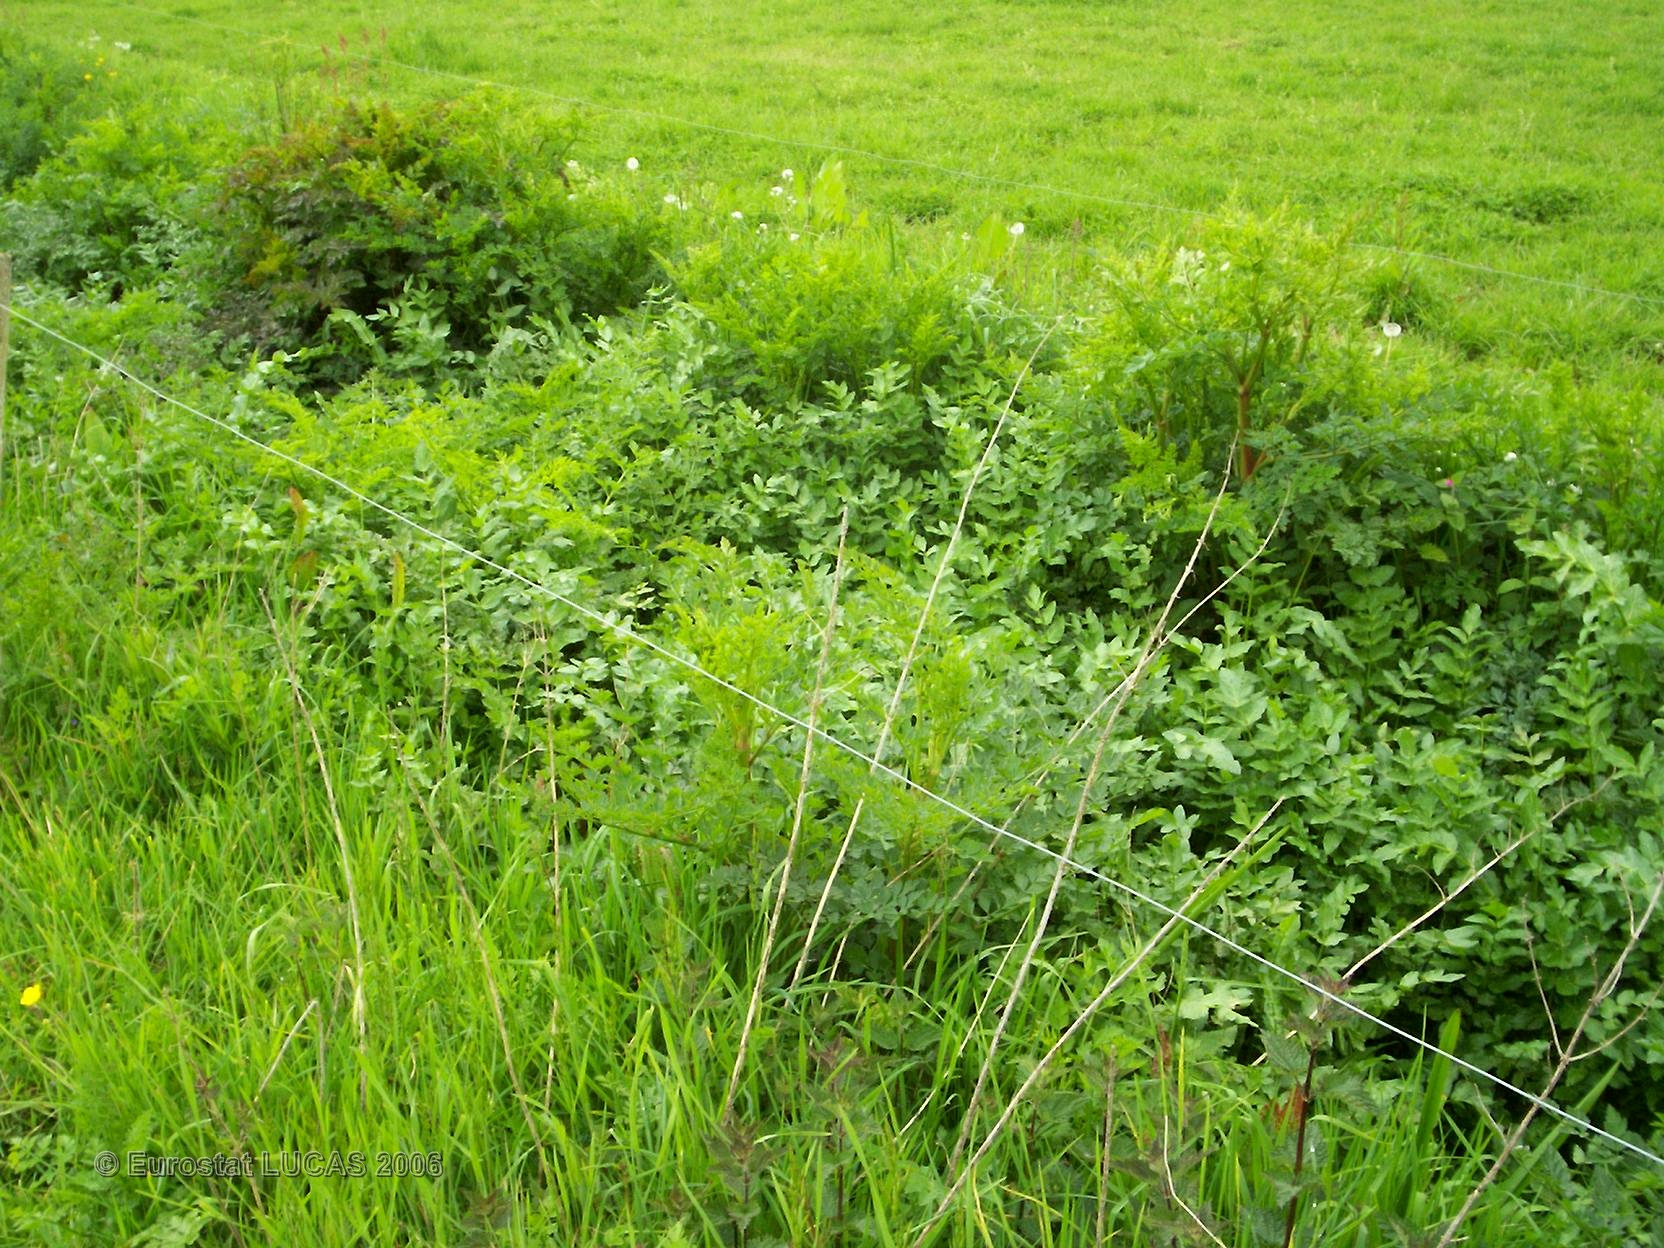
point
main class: Grassland
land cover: Grassland without tree/shrub cover
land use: Agriculture (excluding fallow land and kitchen gardens)
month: May
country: FR
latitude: 48.2067
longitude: -2.9181
